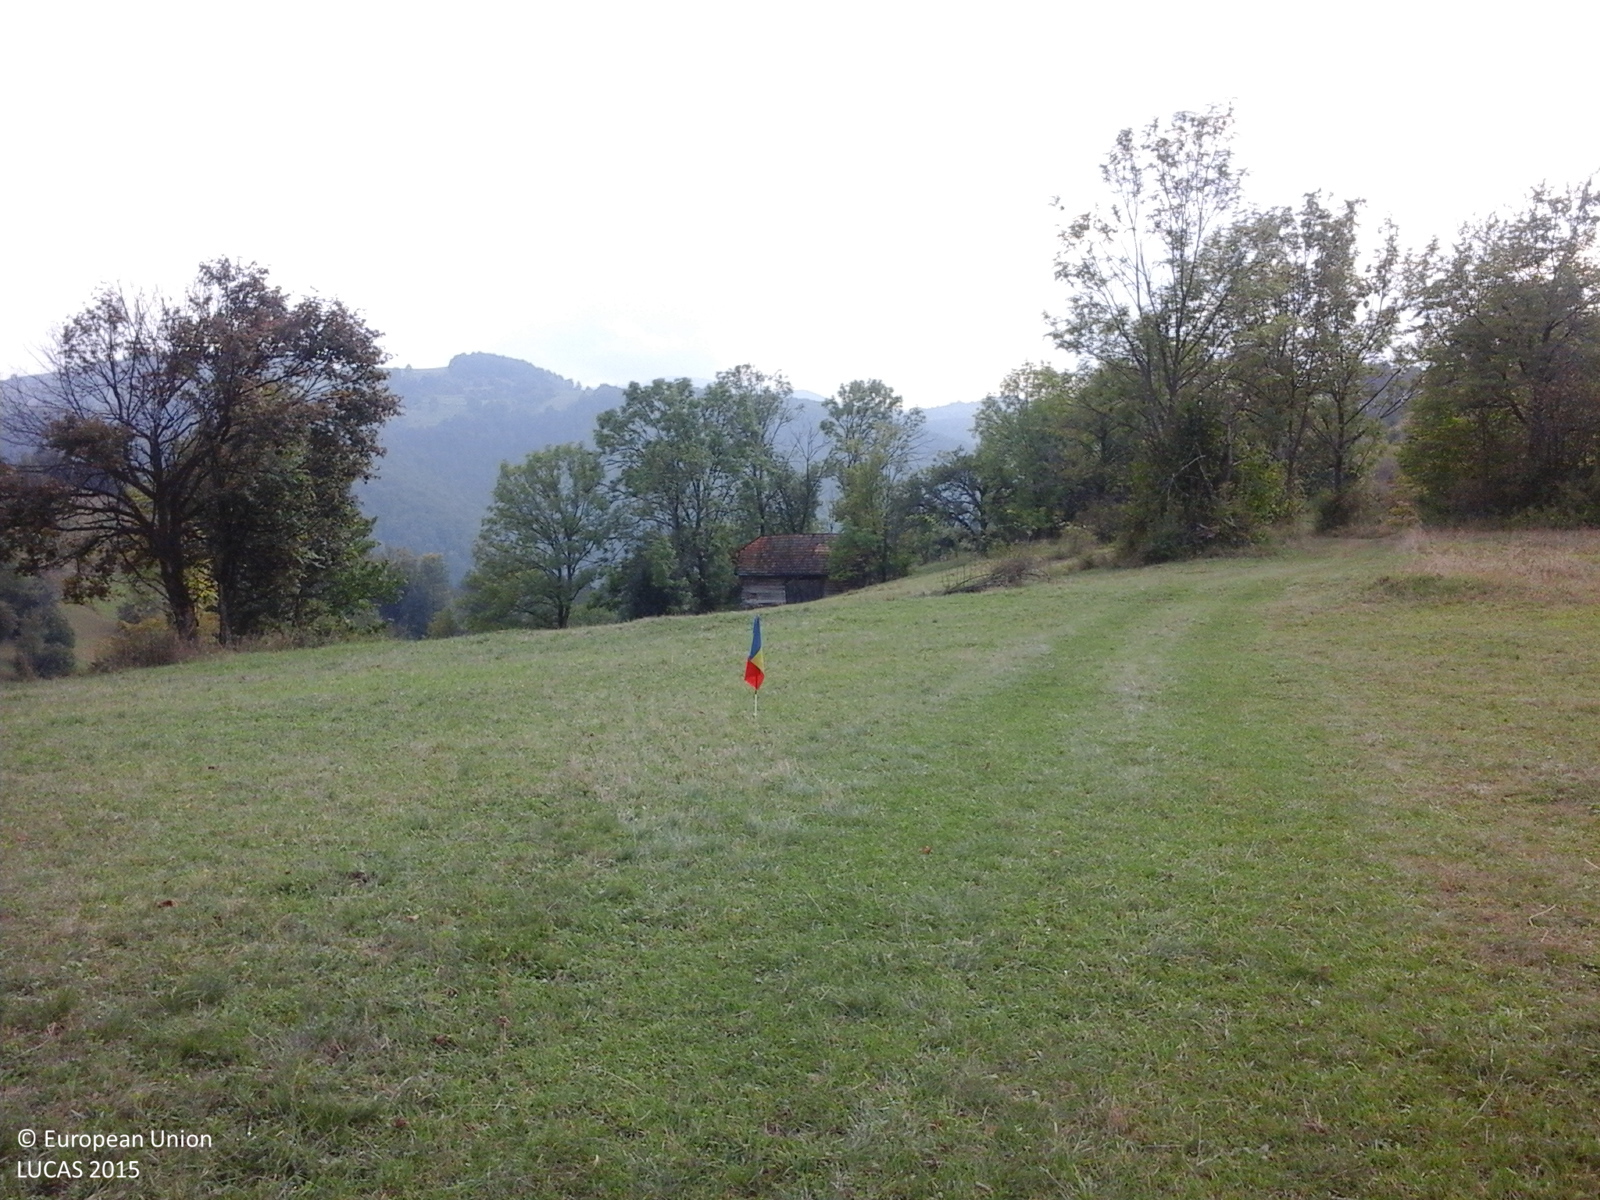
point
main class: Grassland
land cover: Grassland without tree/shrub cover
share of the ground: > 75 %
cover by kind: herbaceous plants 100 %
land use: Agriculture (excluding fallow land and kitchen gardens)
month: September
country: RO
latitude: 46.9235
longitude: 22.6769
